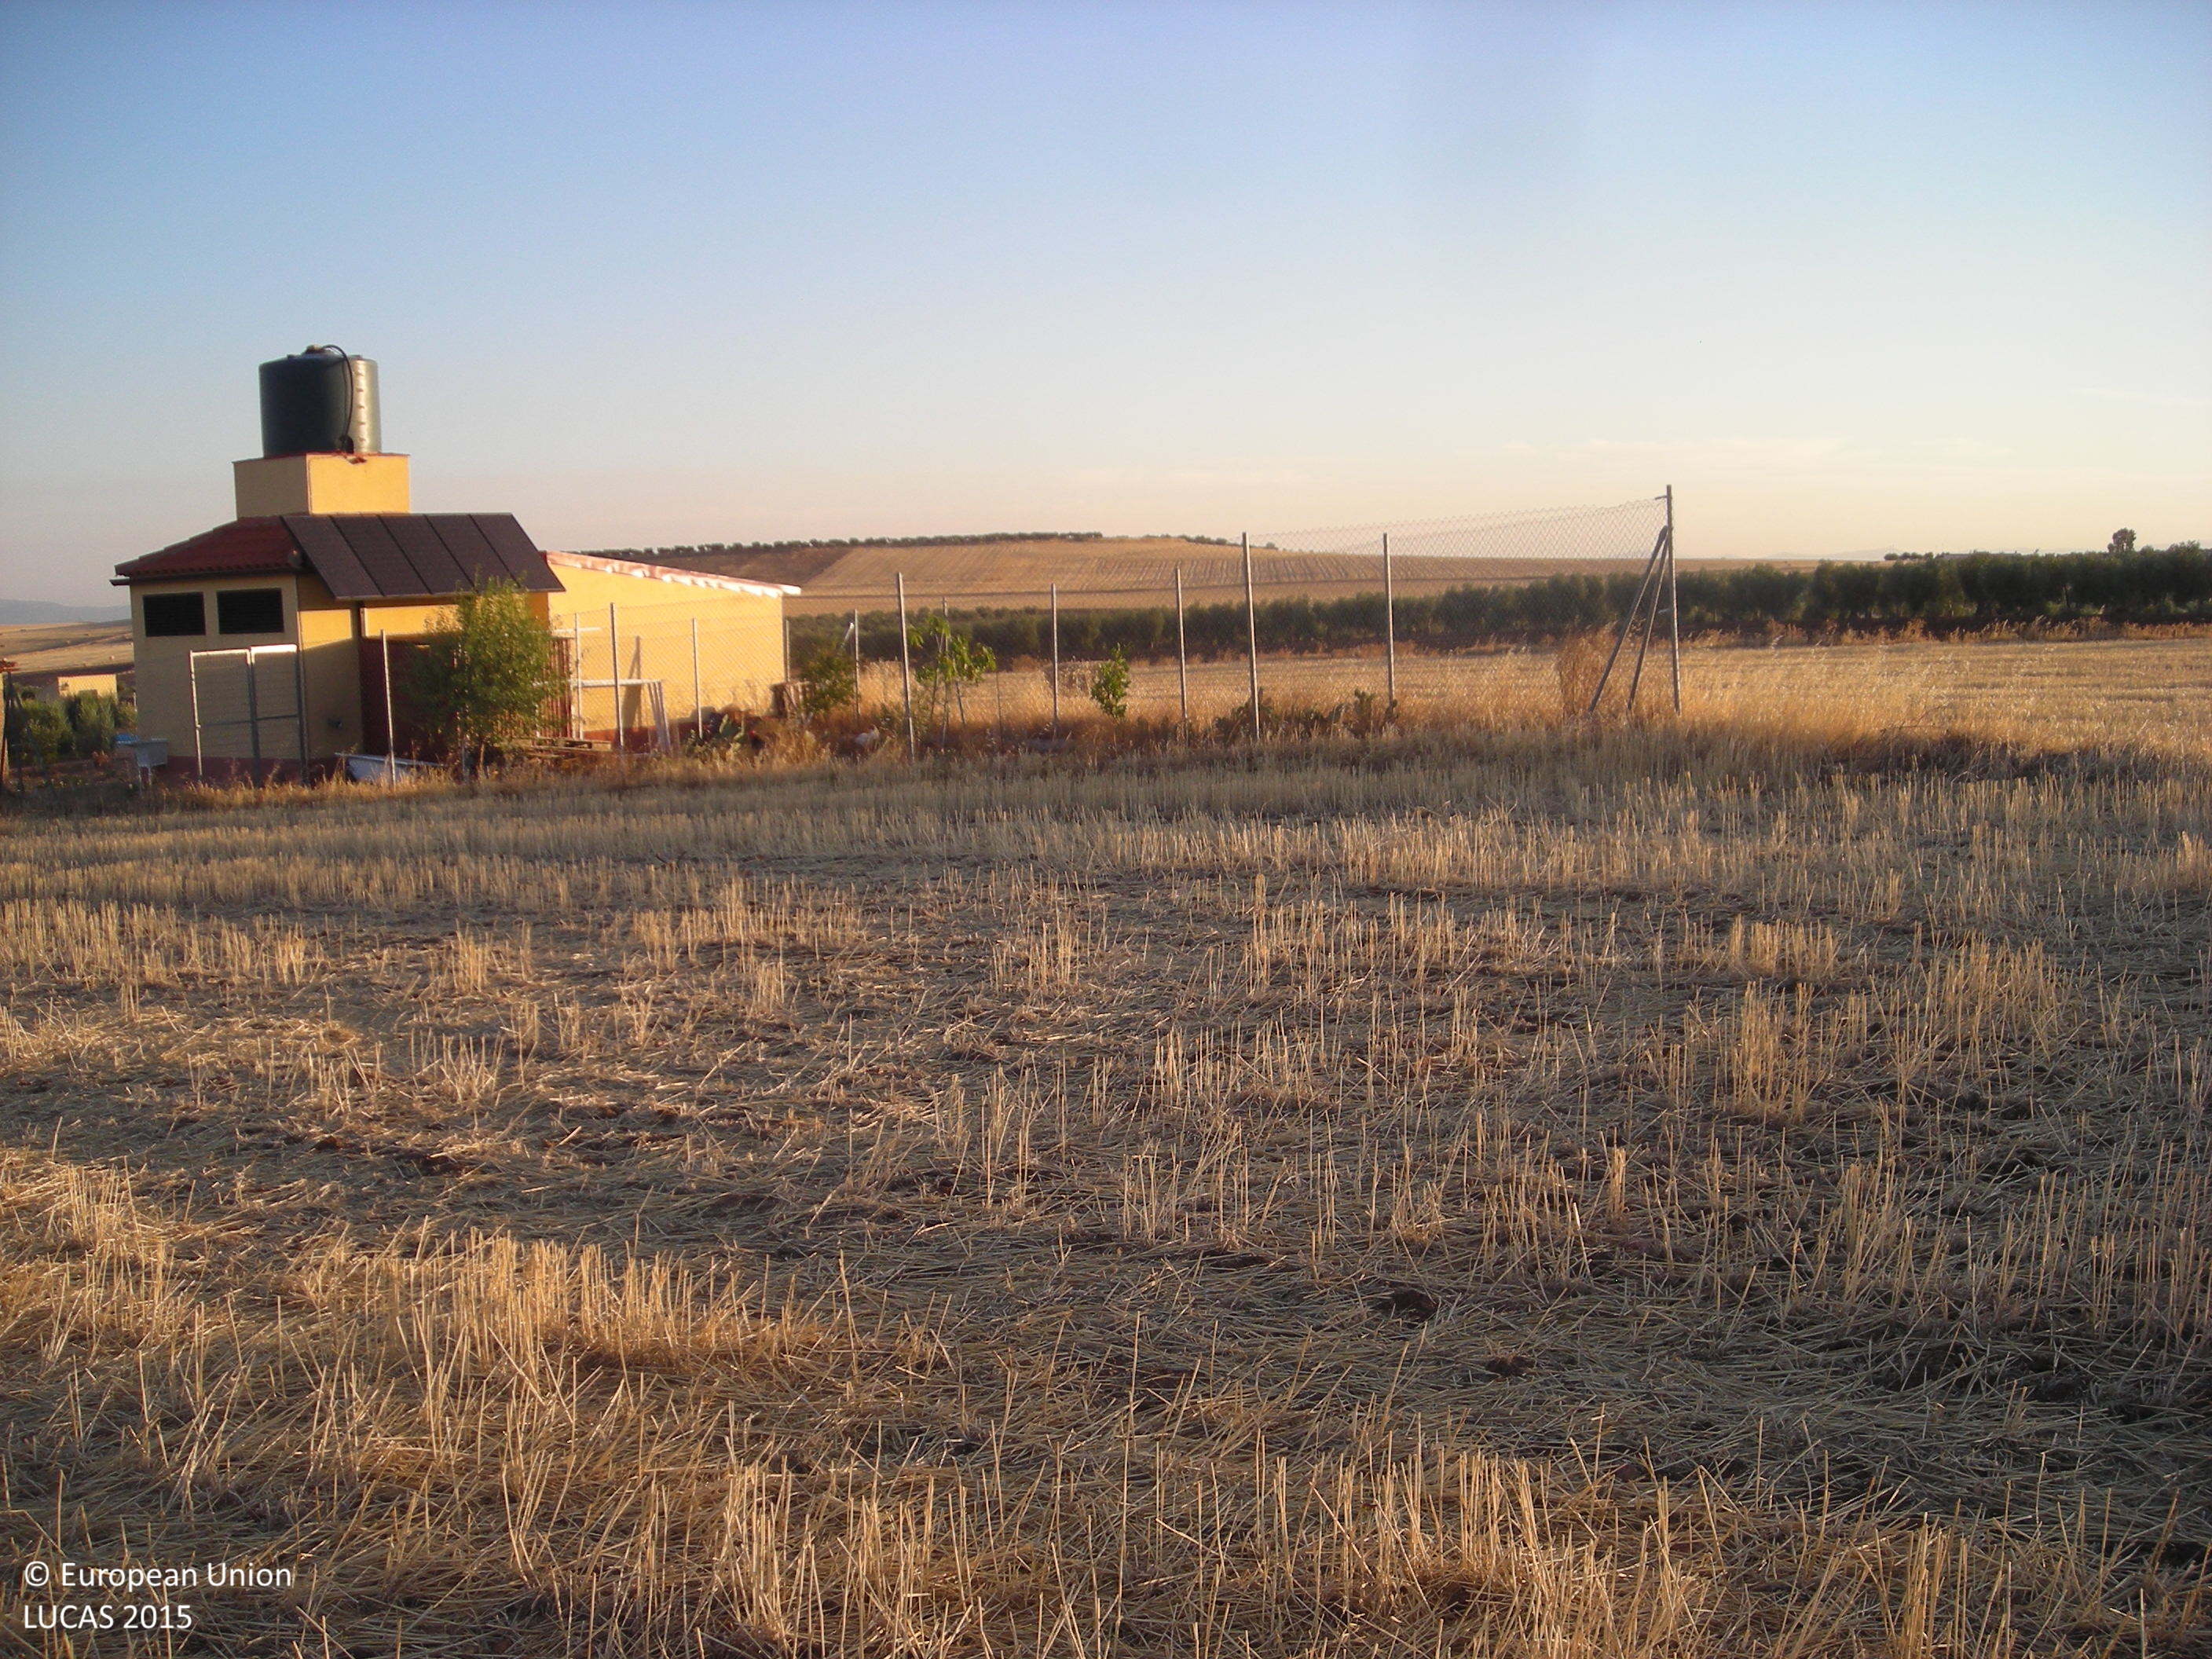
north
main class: Cropland
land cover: Common wheat
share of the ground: > 75 %
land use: Agriculture (excluding fallow land and kitchen gardens)
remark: Harvested field
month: July
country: ES
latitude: 38.9026
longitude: -5.8103
